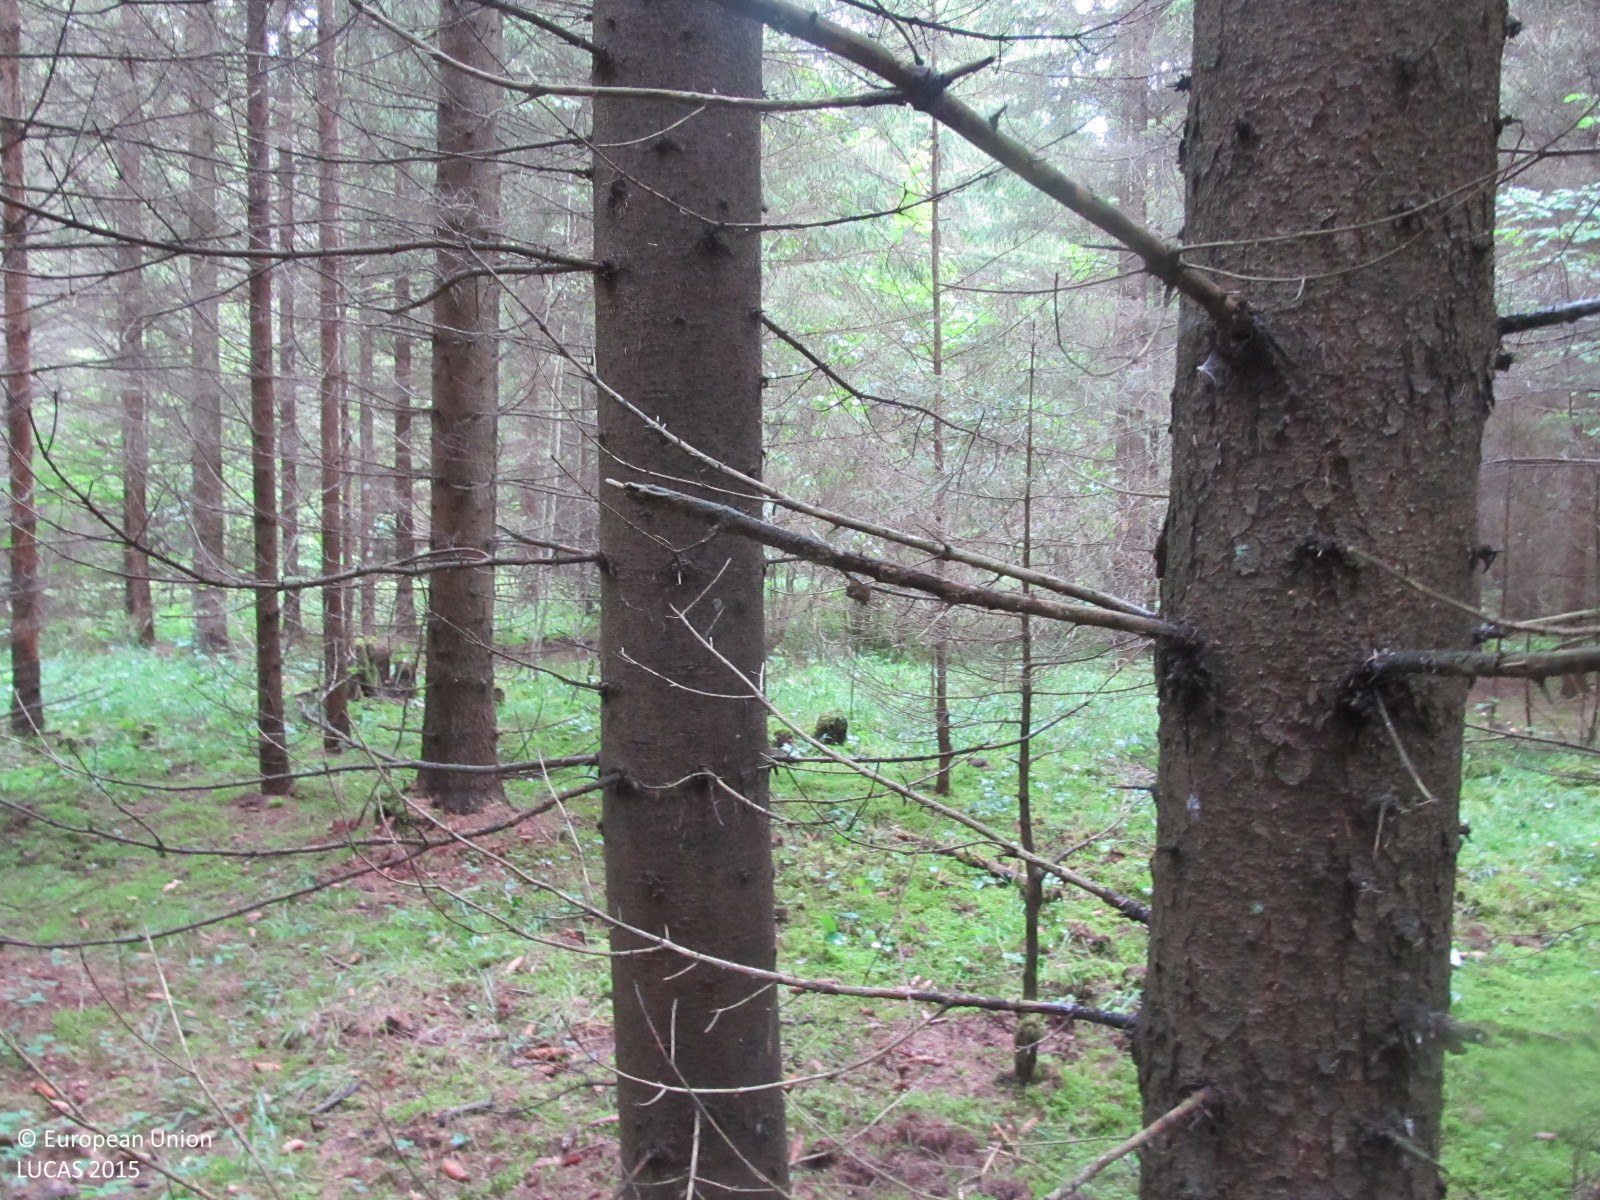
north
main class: Woodland
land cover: Spruce dominated coniferous woodland
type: hemiboreal forest and nemoral coniferous forest and mixed broadleaved-coniferous forest
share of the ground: > 75 %
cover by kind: coniferous forest trees 80 %, lichens and mosses 15 %, herbaceous plants 5 %
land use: Forestry
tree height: > 5 m
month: September
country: LT
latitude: 56.0648
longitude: 23.2262
